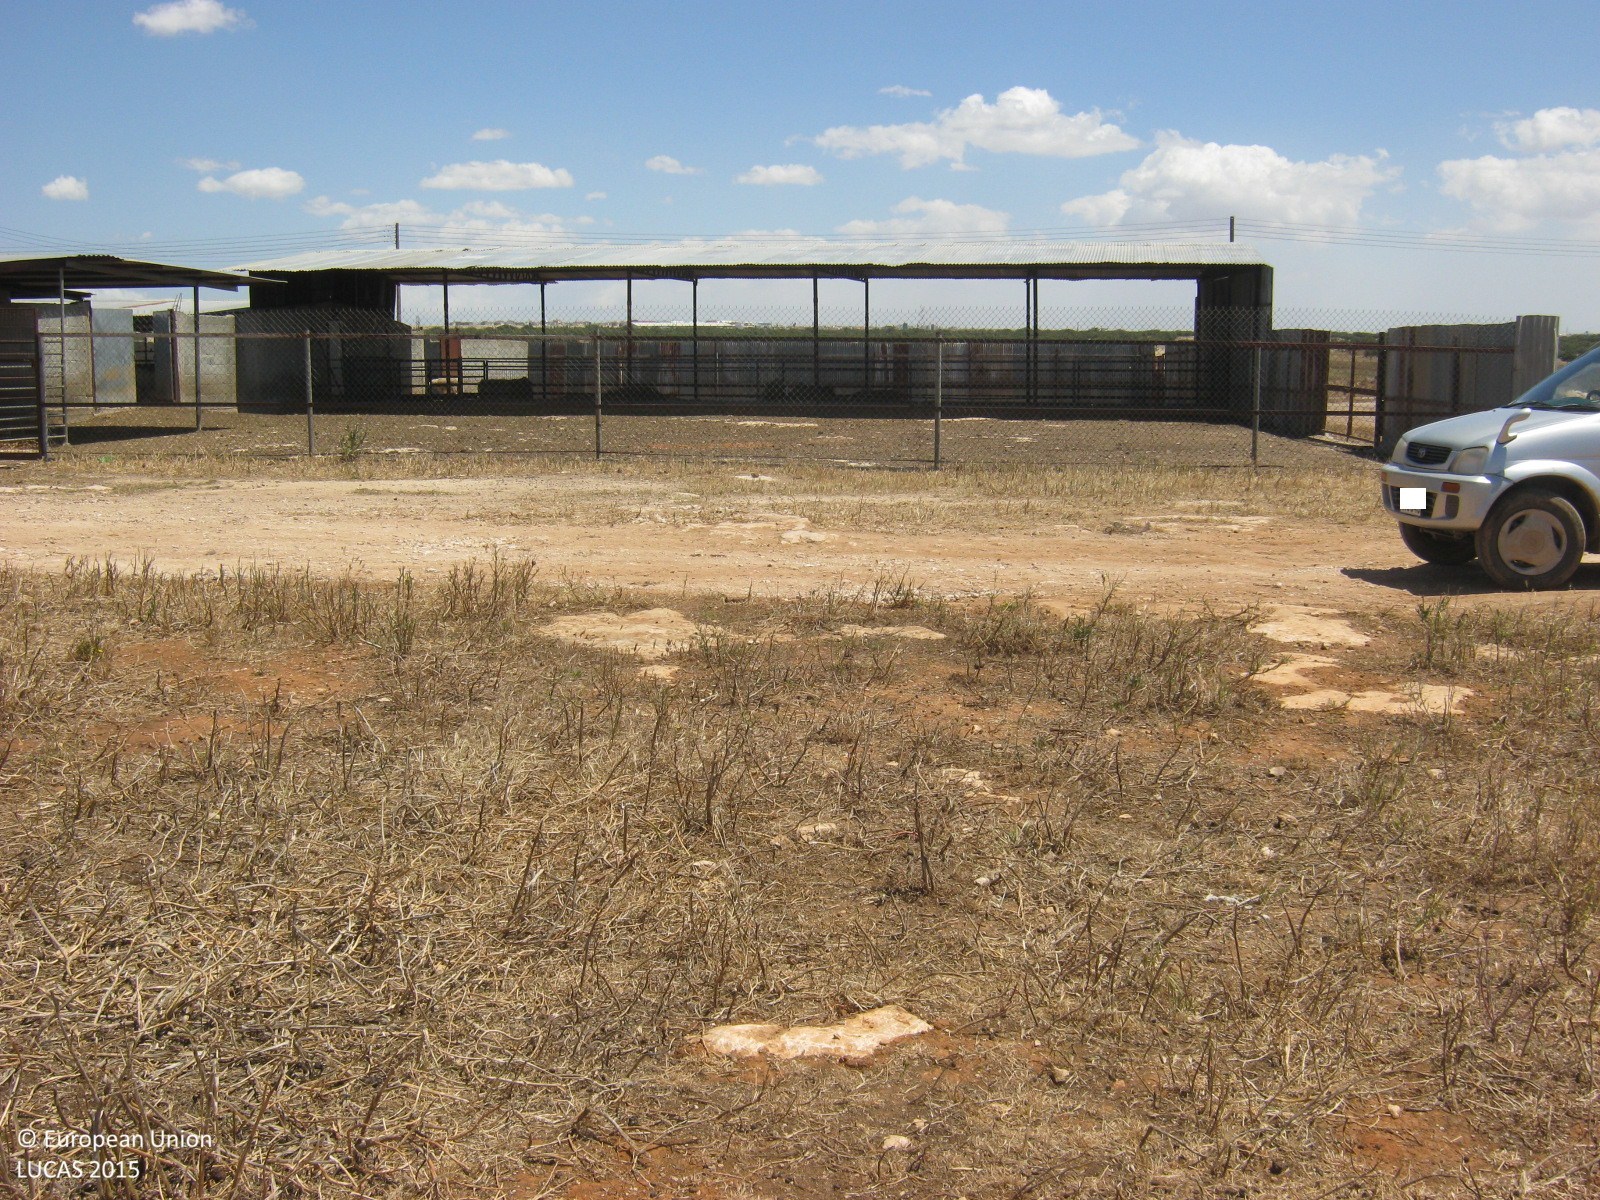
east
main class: Grassland
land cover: Spontaneously vegetated surfaces
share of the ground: 25 - 50 %
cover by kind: unconsolidated bare surface 55 %, herbaceous plants 45 %
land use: Agriculture (excluding fallow land and kitchen gardens)
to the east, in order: Spontaneously vegetated surfaces; Tracks; Artificial constructions in urban areas; Spontaneously vegetated surfaces; Tracks; Electric lines; Shrubland without tree cover; Spontaneously vegetated surfaces; Rivers and streams; Shrubland without tree cover
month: May
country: CY
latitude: 35.1645
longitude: 33.1644
